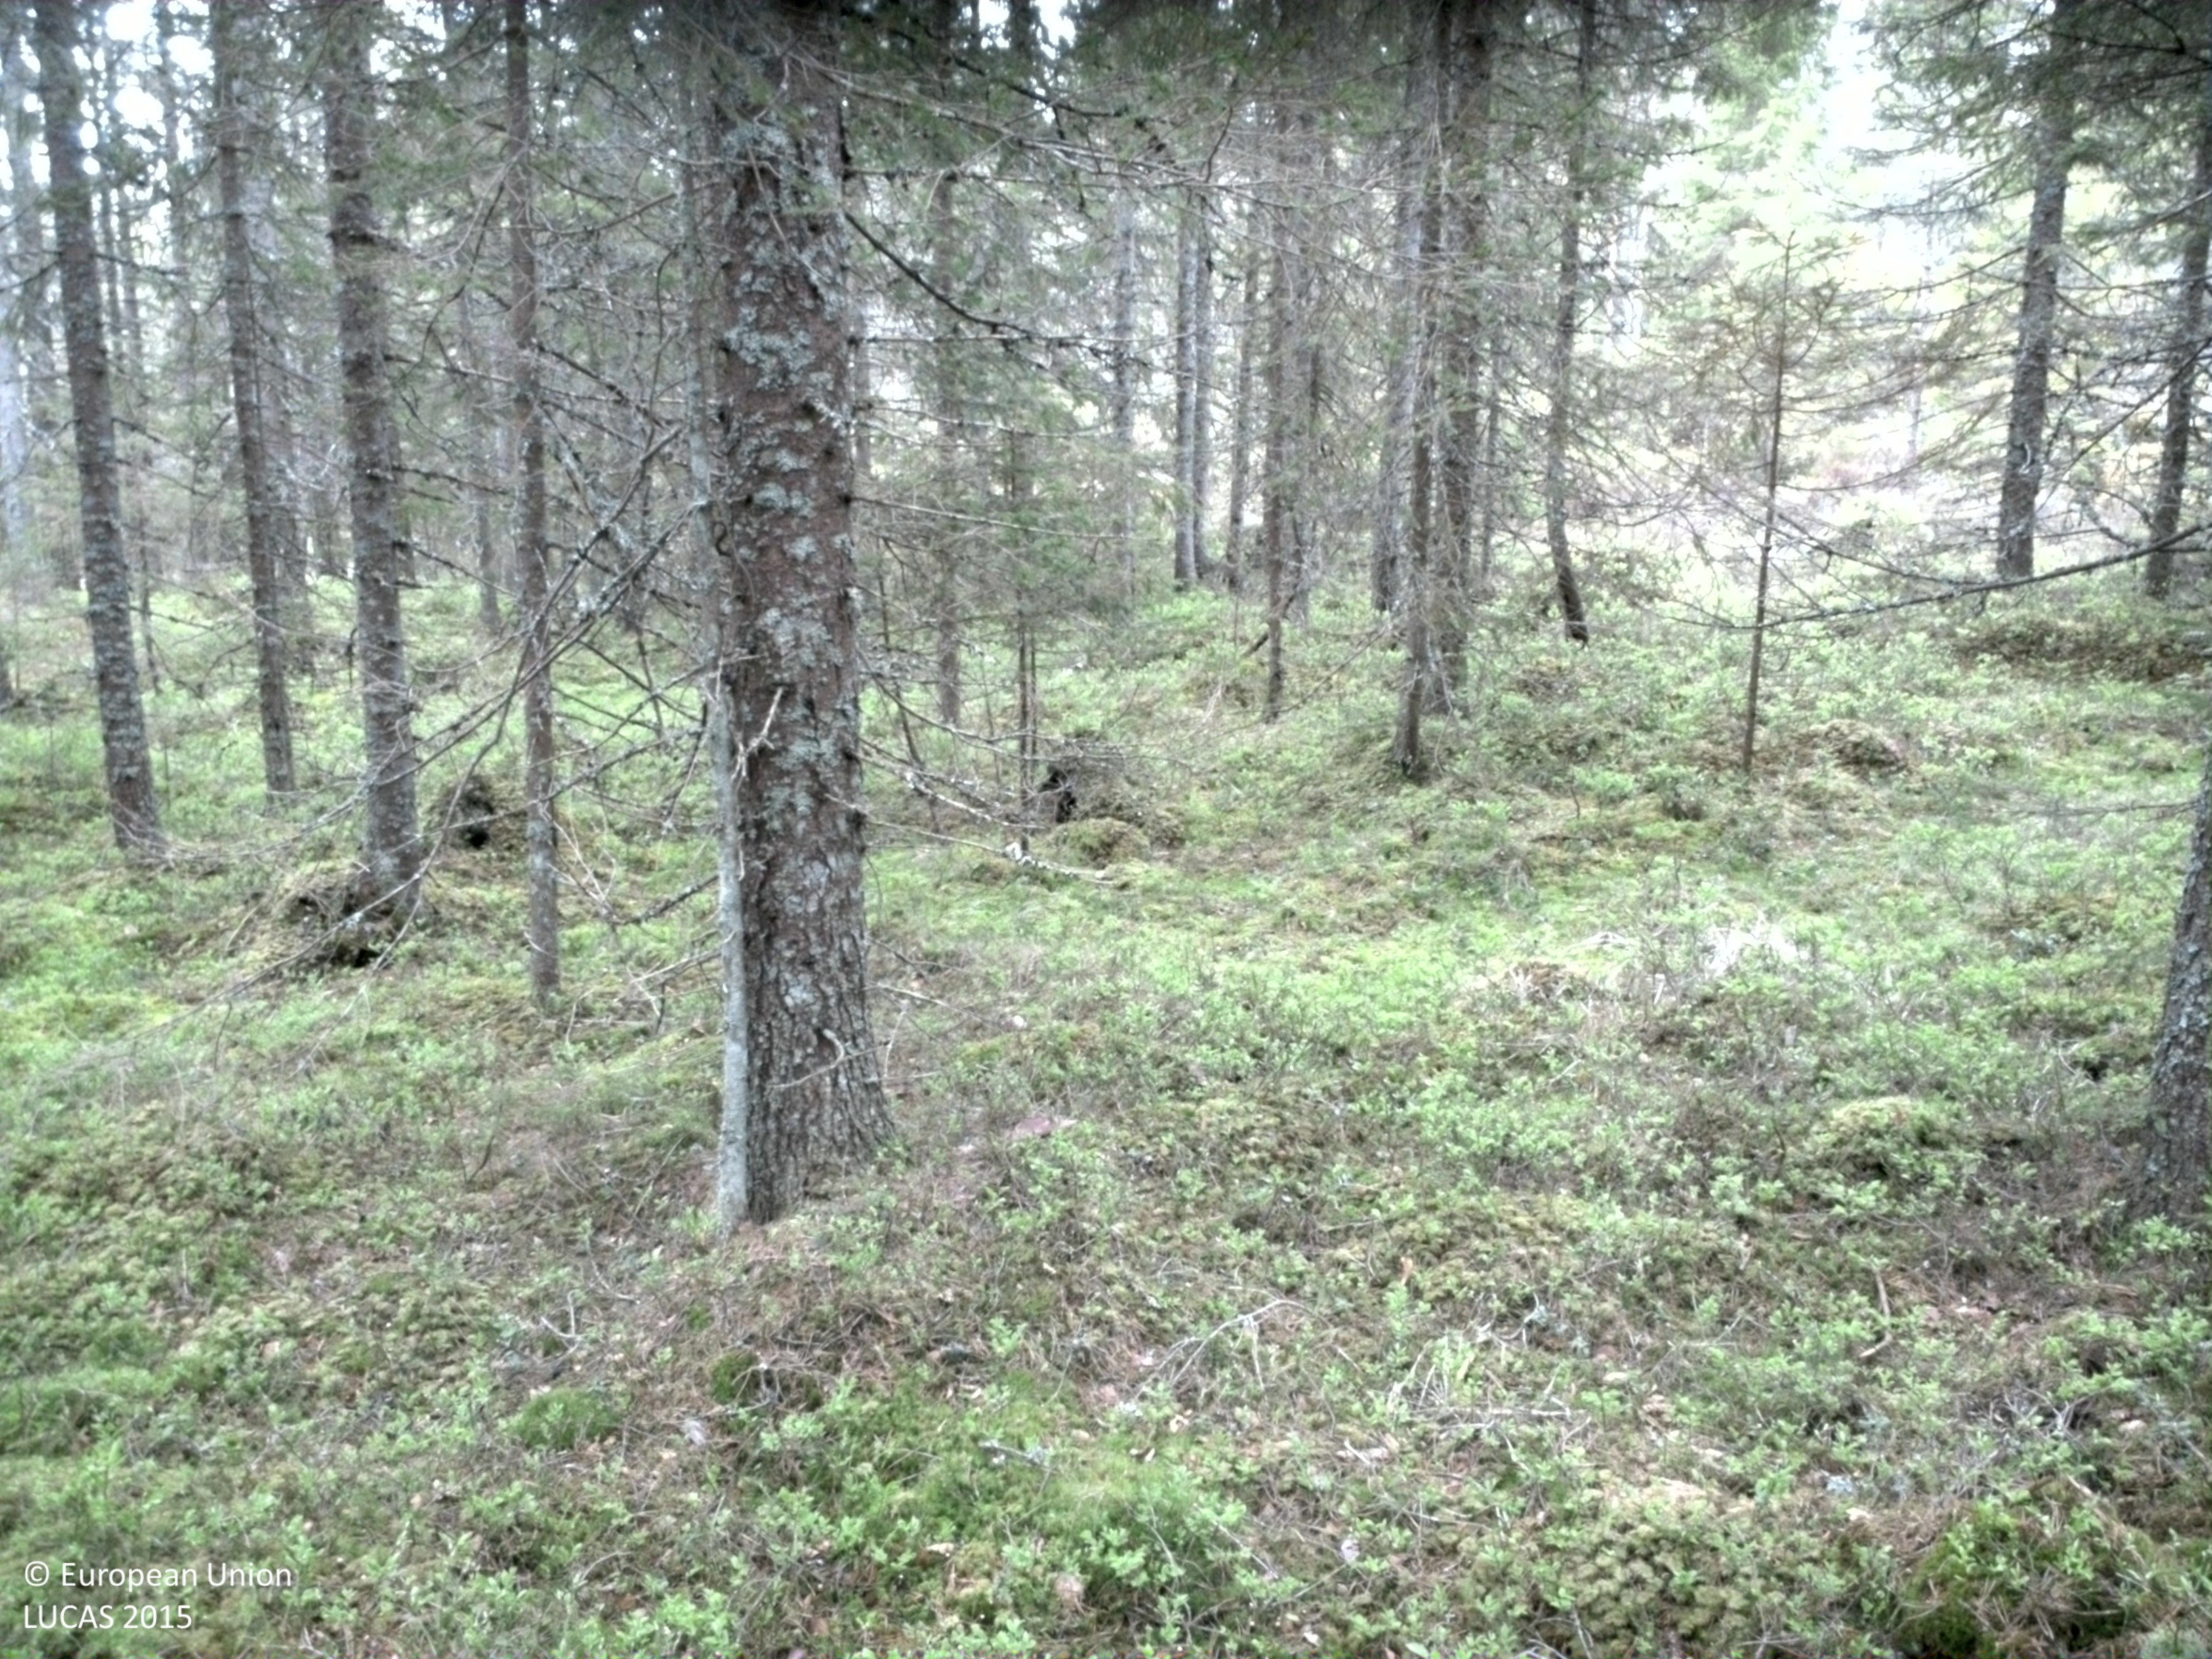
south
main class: Woodland
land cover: Spruce dominated coniferous woodland
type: boreal forest
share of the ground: > 75 %
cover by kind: coniferous forest trees 75 %, shrubs 10 %, lichens and mosses 10 %, broadleaved forest trees 5 %
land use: Forestry
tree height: > 5 m
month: May
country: SE
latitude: 59.6231
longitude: 12.2102
